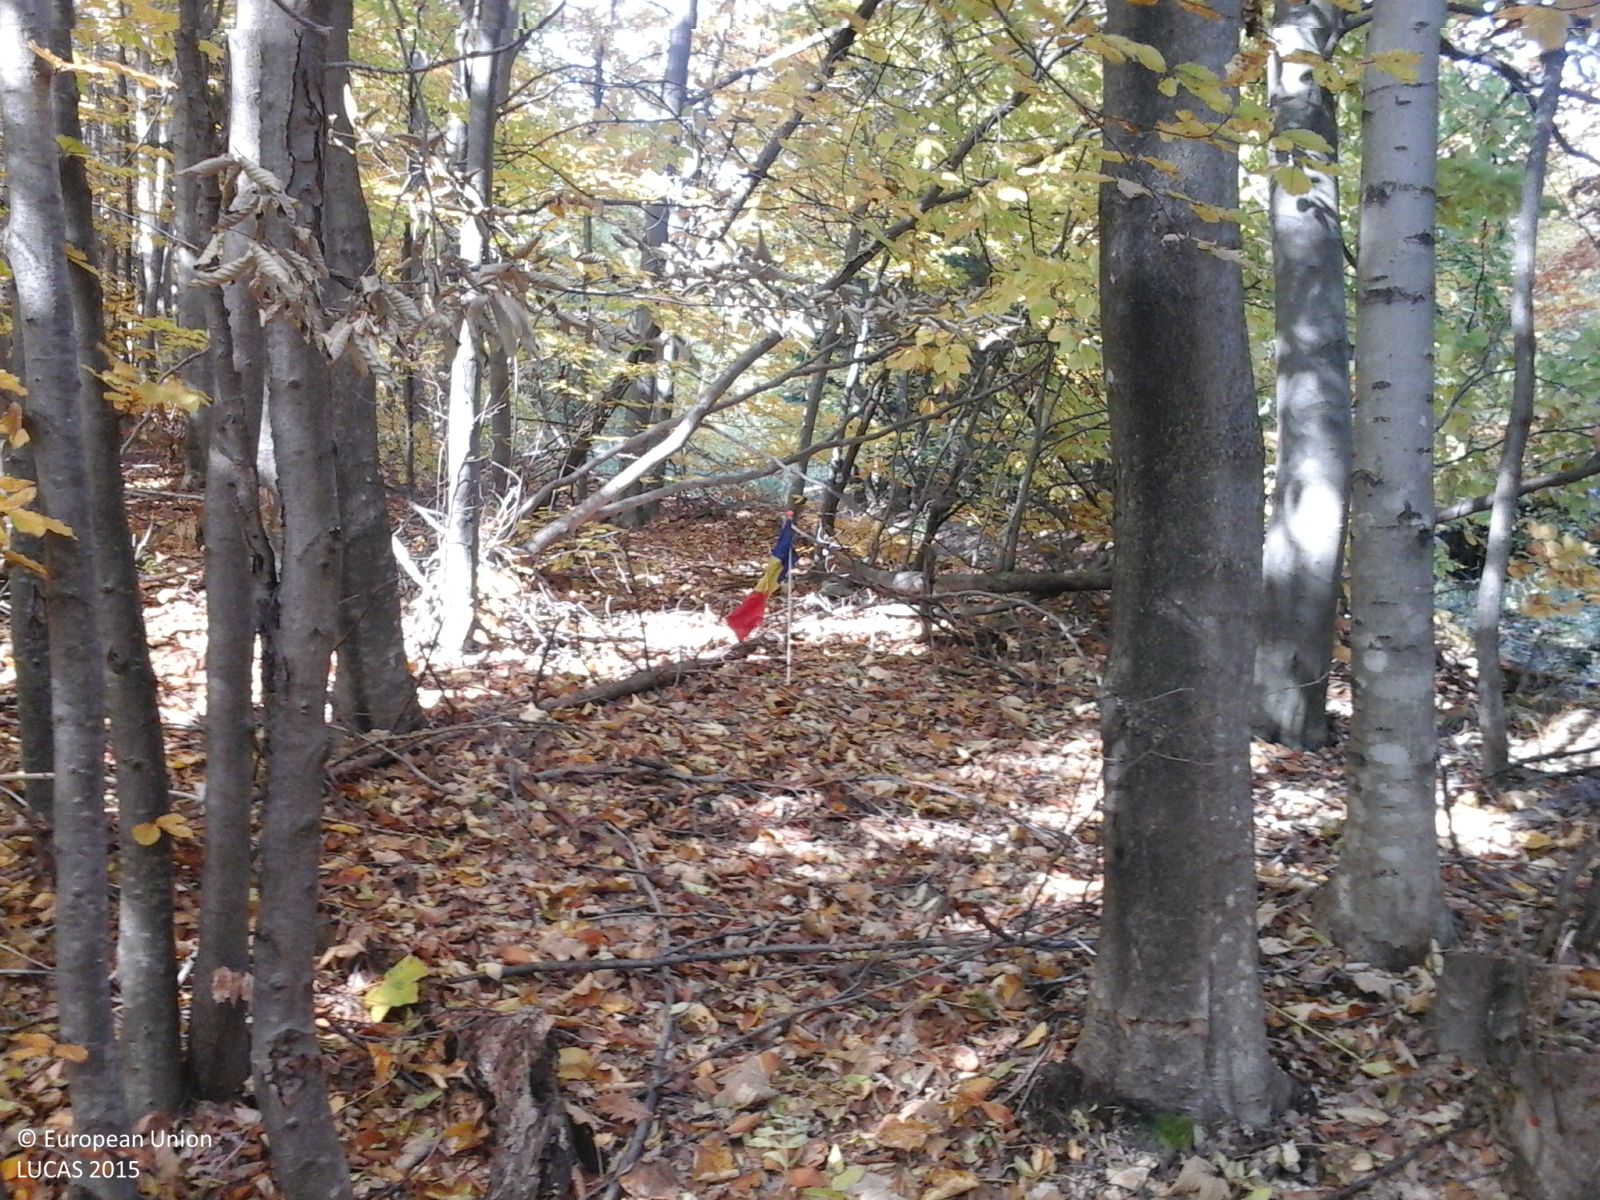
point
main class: Woodland
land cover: Broadleaved woodland
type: beech forest
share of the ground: > 75 %
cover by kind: broadleaved forest trees 100 %
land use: Forestry
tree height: > 5 m
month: October
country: RO
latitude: 46.0471
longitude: 26.6372
